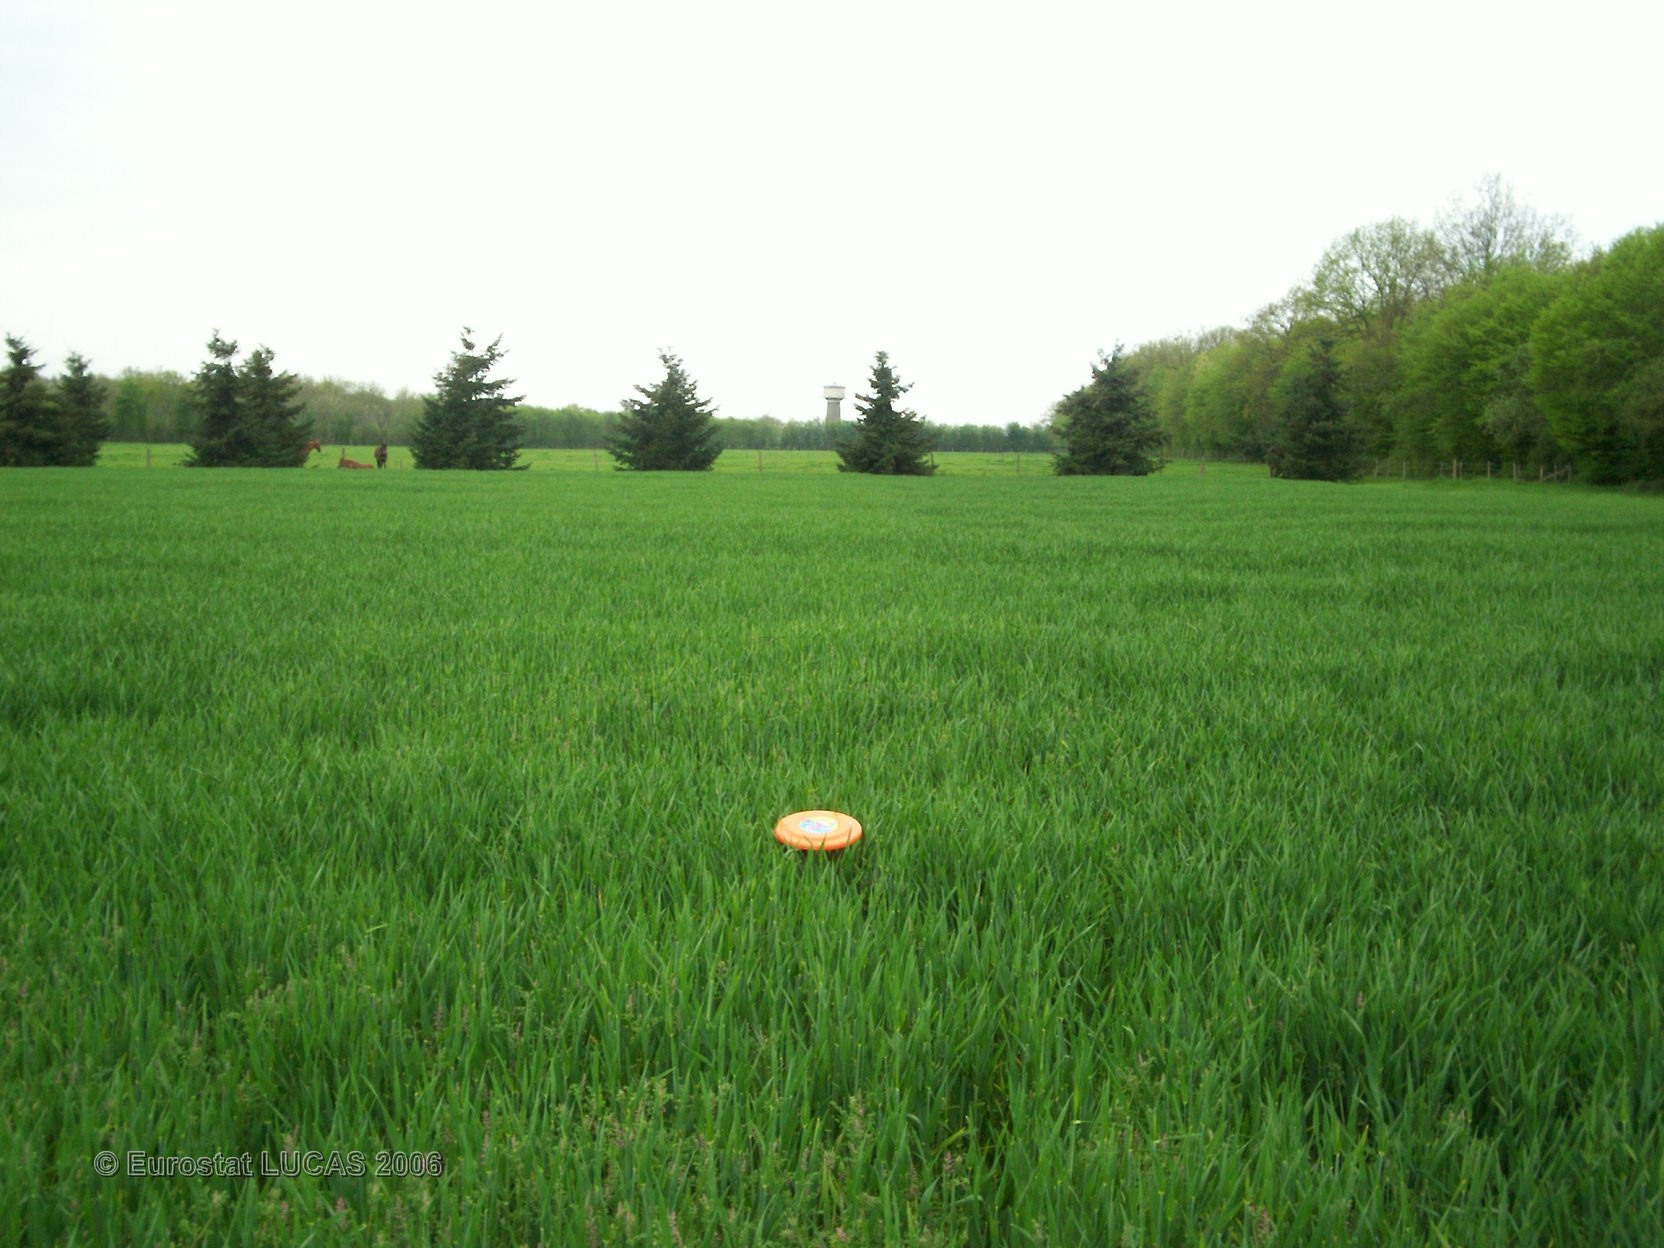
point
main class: Cropland
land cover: Barley
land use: Agriculture (excluding fallow land and kitchen gardens)
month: May
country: FR
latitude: 48.9080
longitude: 0.6020
